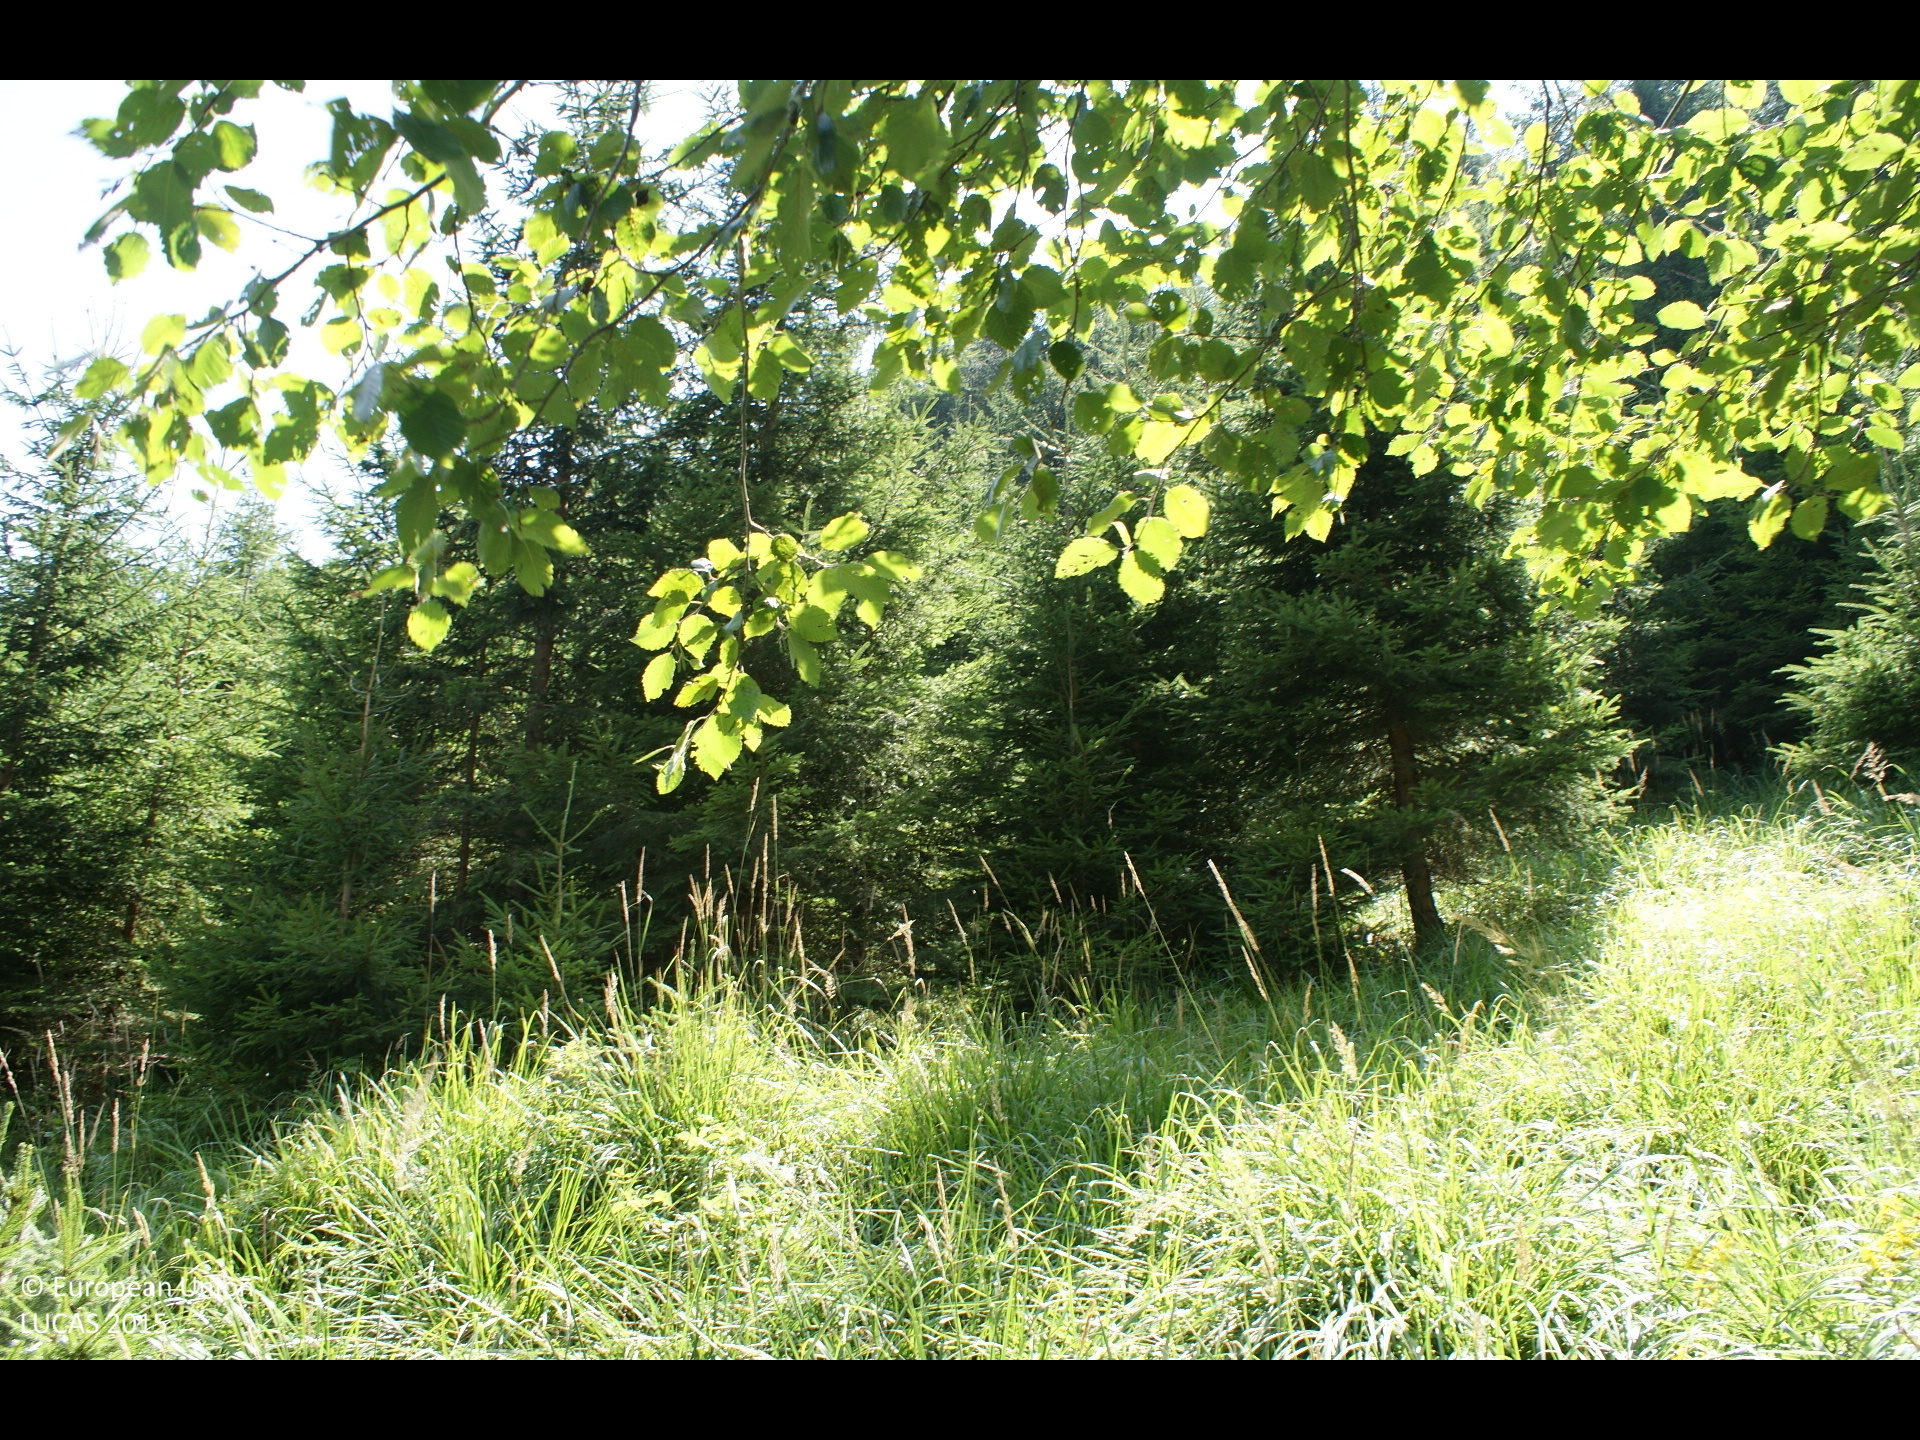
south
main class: Shrubland
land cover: Shrubland with sparse tree cover
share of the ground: > 75 %
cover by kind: herbaceous plants 55 %, shrubs 40 %, broadleaved forest trees 5 %
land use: Forestry
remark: Clear cut
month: August
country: AT
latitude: 47.6035
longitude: 15.4146
